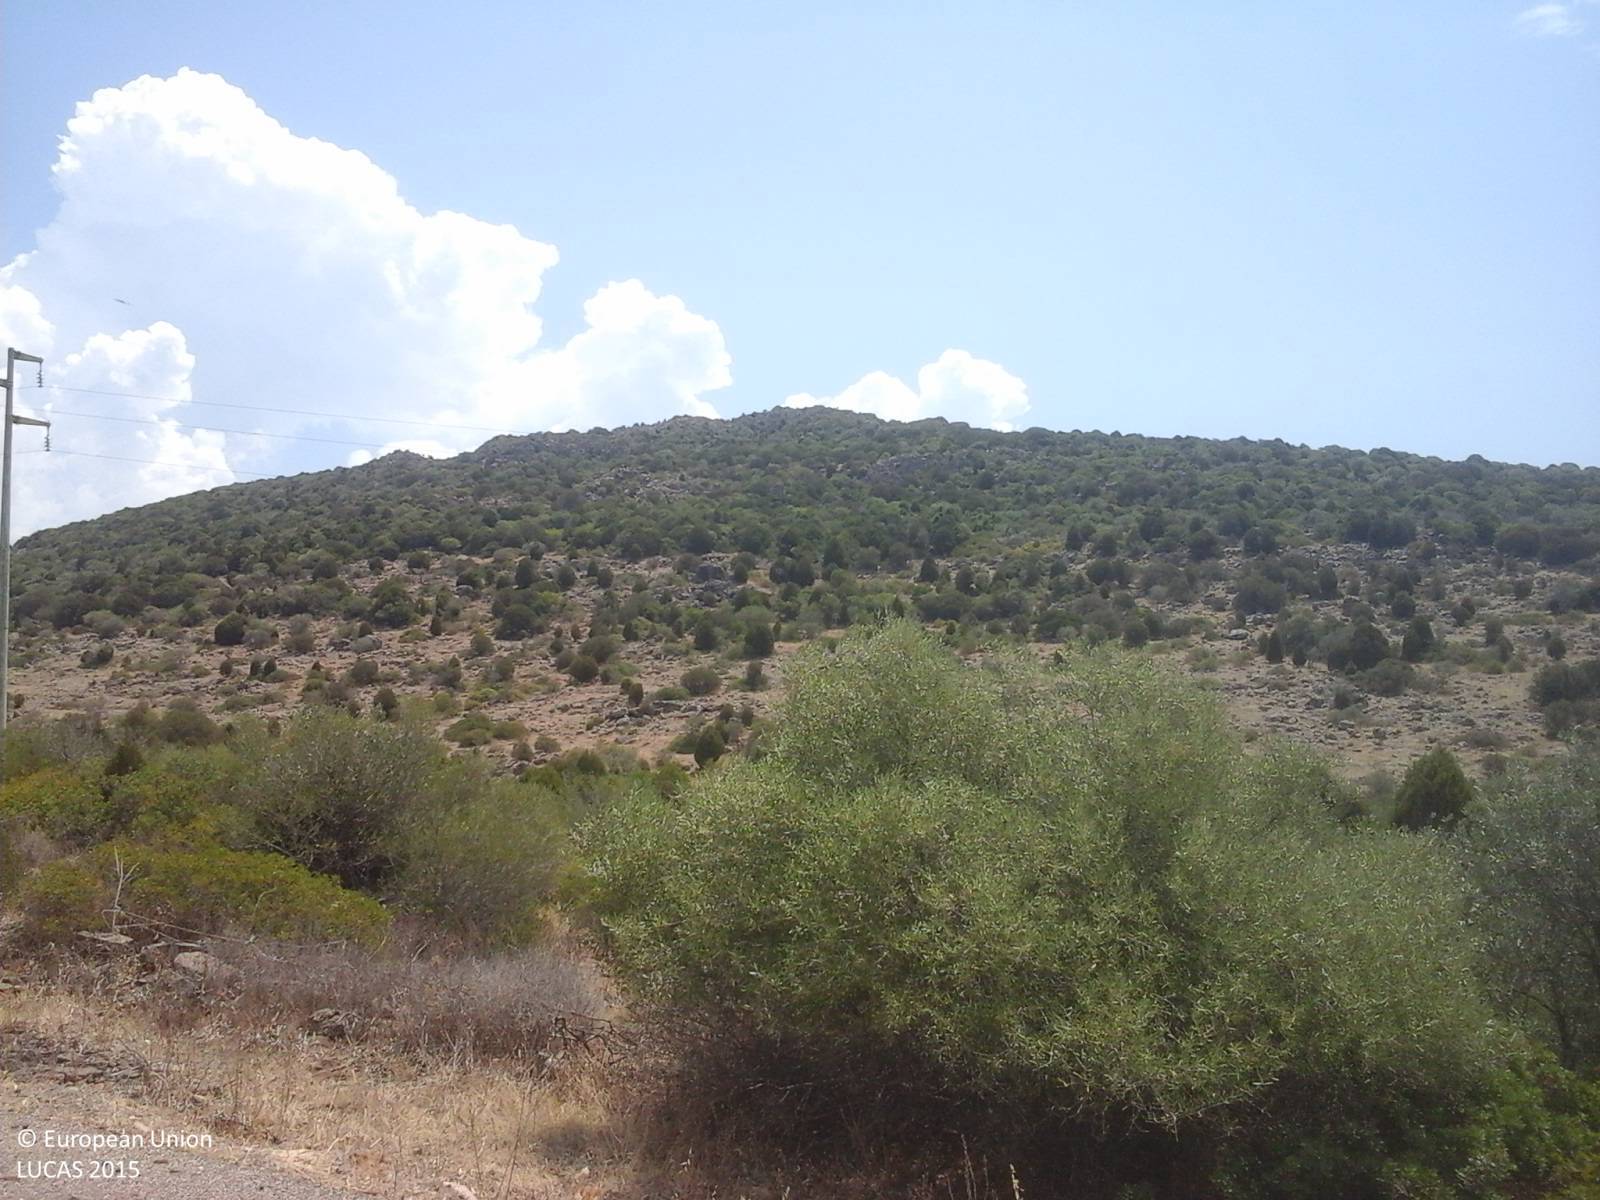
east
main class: Shrubland
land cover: Shrubland with sparse tree cover
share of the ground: > 75 %
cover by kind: shrubs 70 %, unconsolidated bare surface 20 %, broadleaved forest trees 5 %, herbaceous plants 5 %
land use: Agriculture (excluding fallow land and kitchen gardens)
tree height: < 5 m
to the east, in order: Shrubland with sparse tree cover
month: July
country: IT
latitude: 39.1165
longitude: 8.6323
